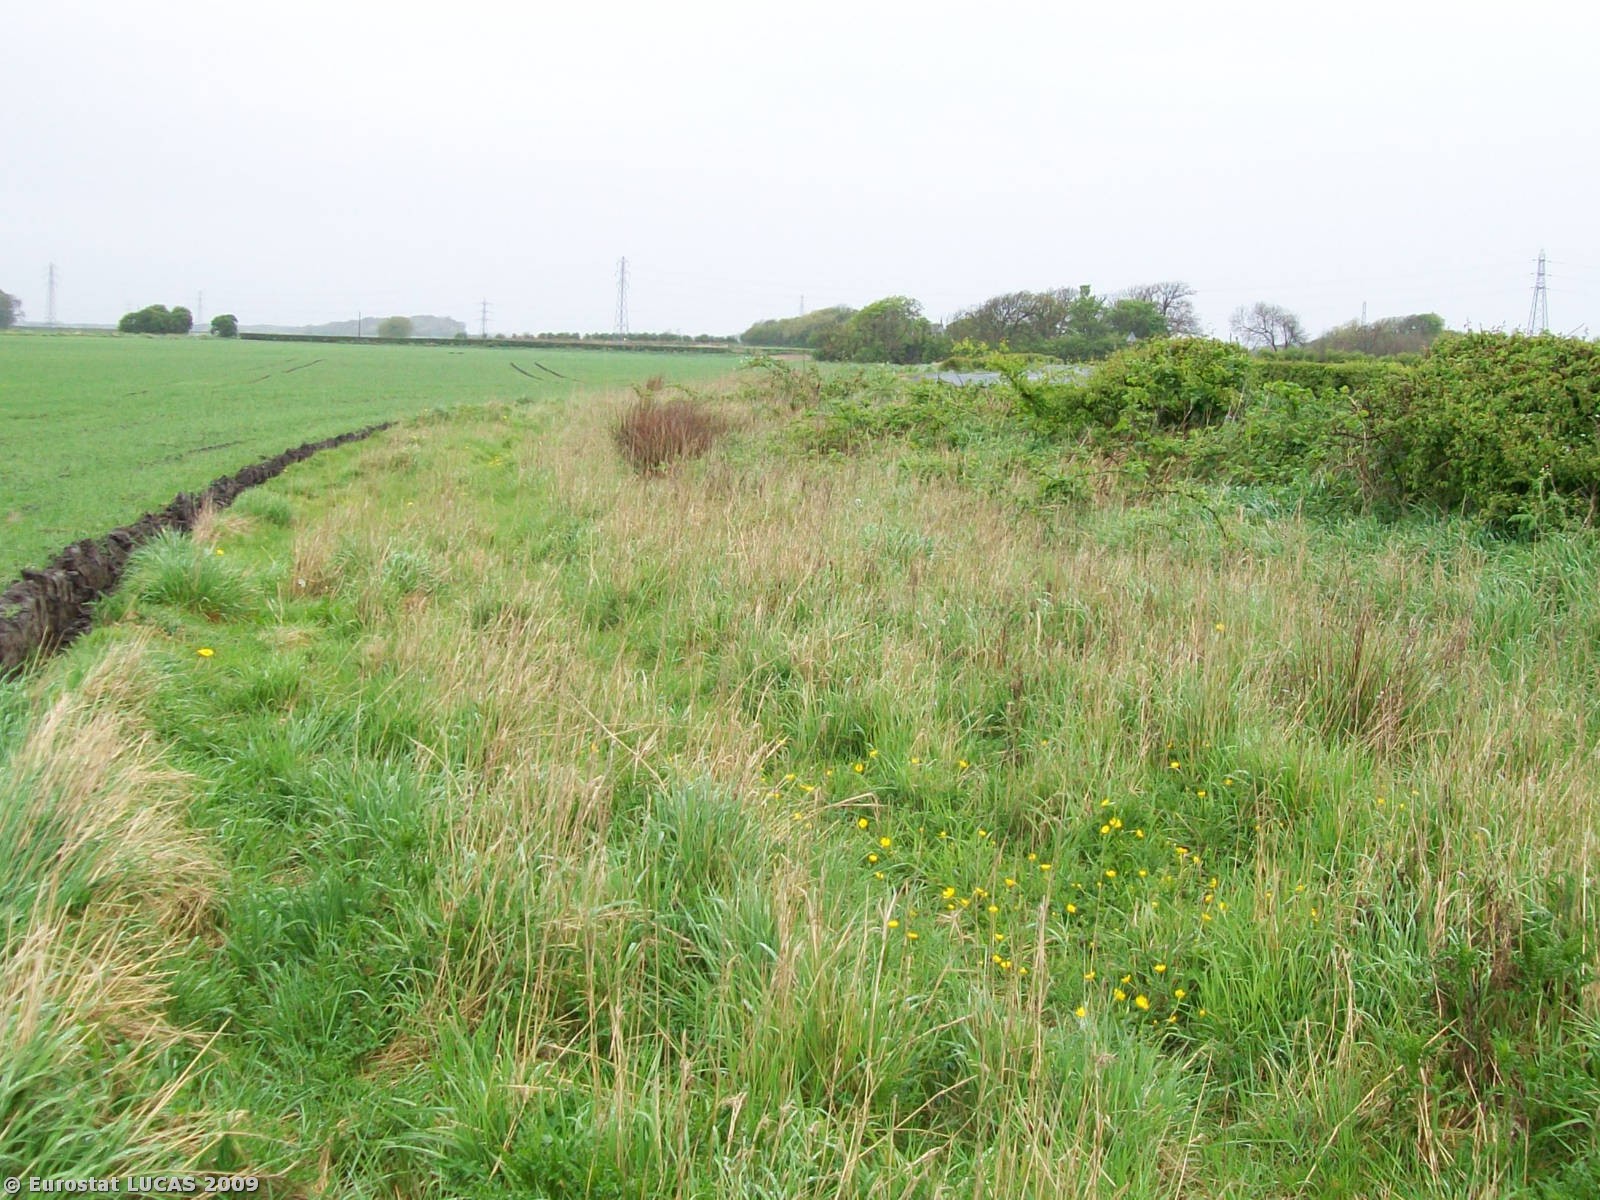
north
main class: Cropland
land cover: Barley
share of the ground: 50 - 75 %
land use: Agriculture (excluding fallow land and kitchen gardens)
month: May
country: GB
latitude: 53.7596
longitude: -2.9508
